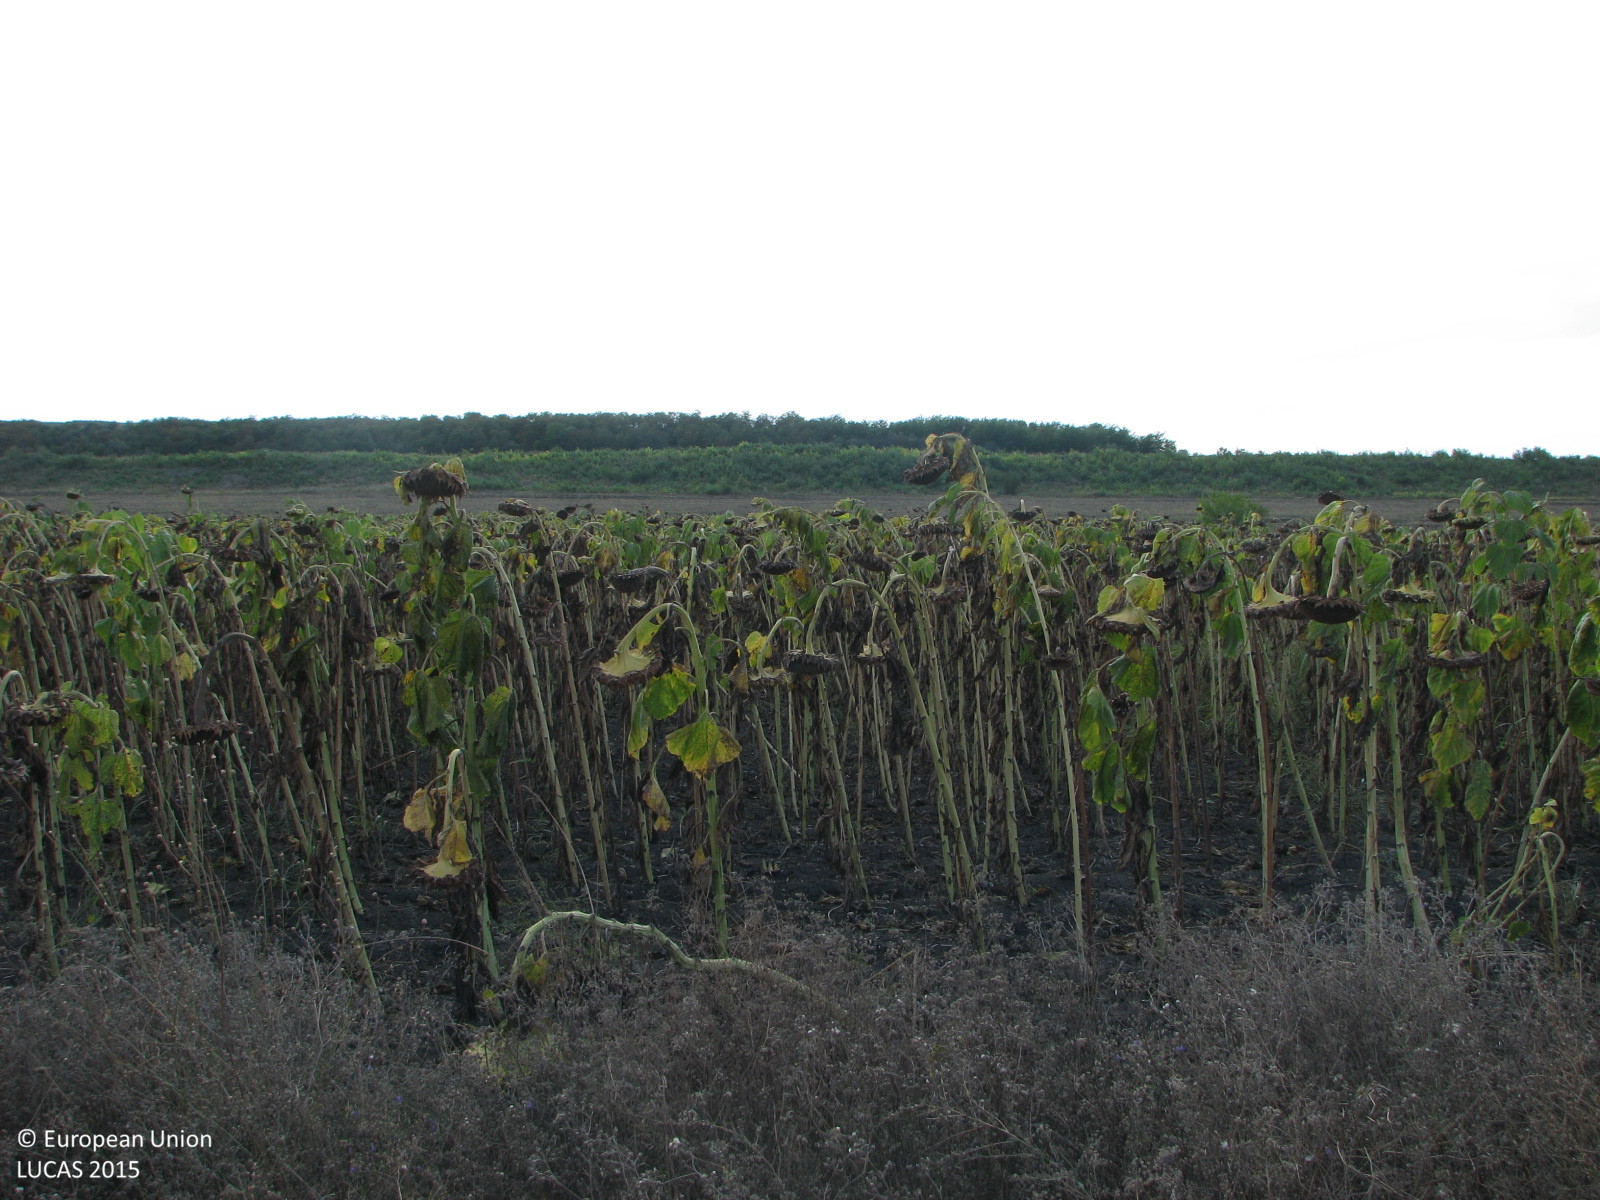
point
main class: Cropland
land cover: Common wheat
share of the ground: > 75 %
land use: Agriculture (excluding fallow land and kitchen gardens)
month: September
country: BG
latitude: 42.2831
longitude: 26.0501
